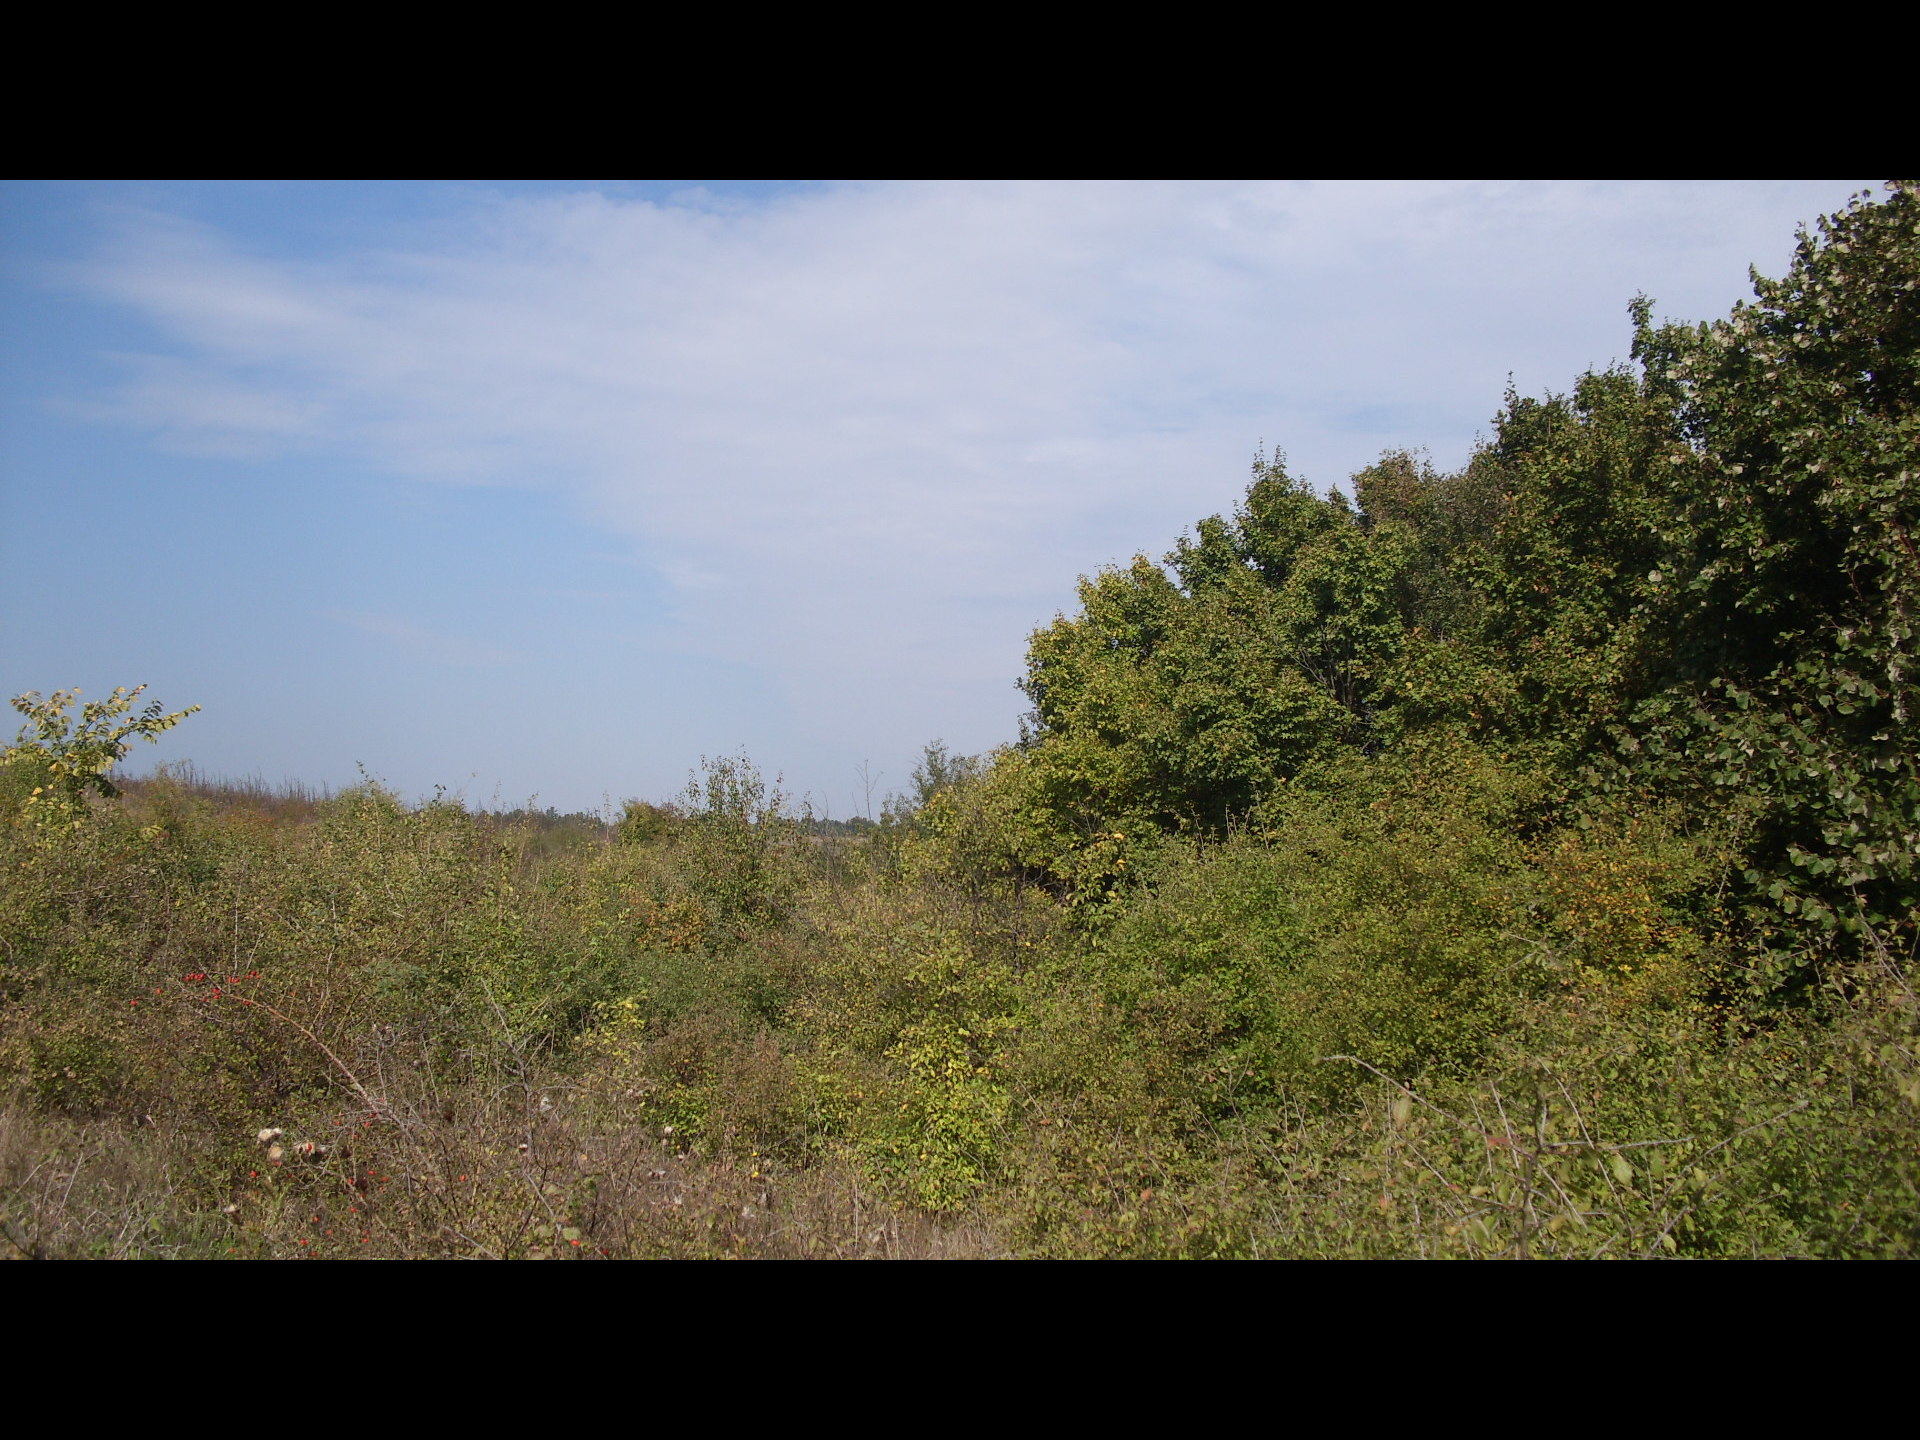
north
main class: Woodland
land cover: Broadleaved woodland
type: mesophytic deciduous forest
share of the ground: > 75 %
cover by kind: broadleaved forest trees 95 %, shrubs 5 %
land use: Forestry
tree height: > 5 m
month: October
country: BG
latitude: 43.8898
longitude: 22.5947
